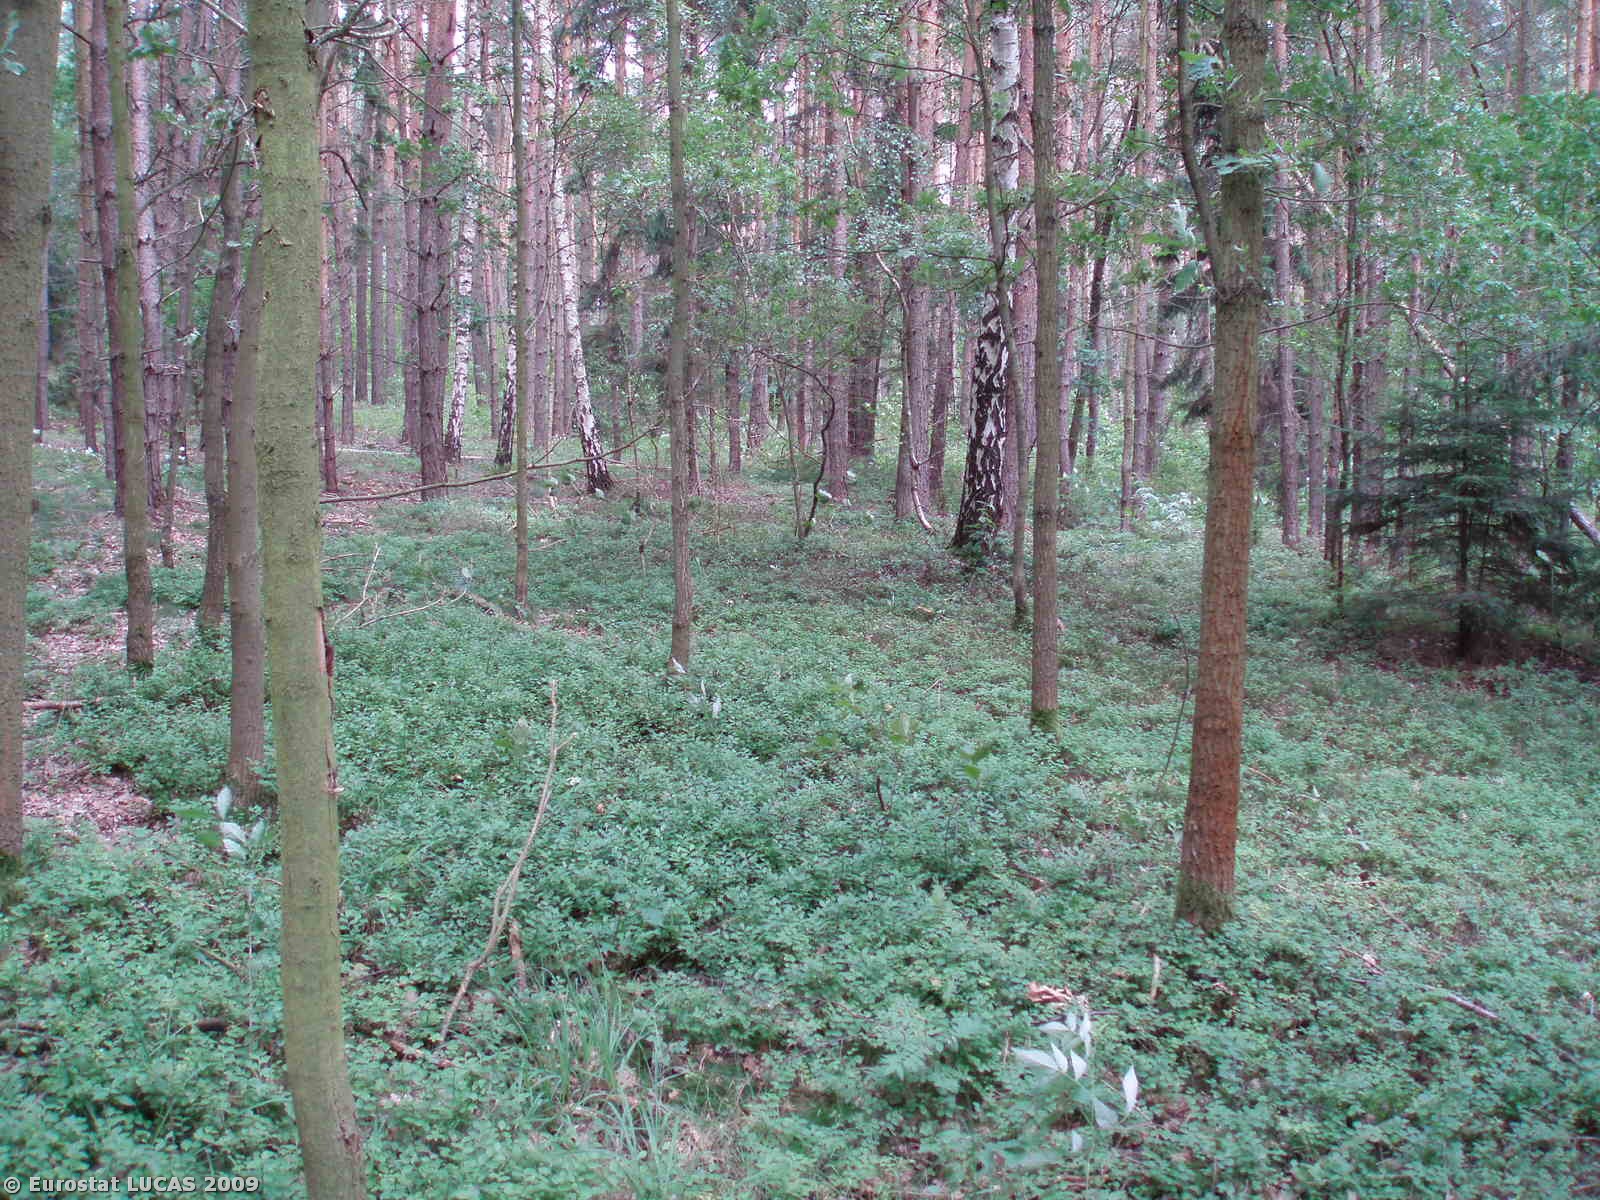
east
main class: Woodland
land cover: Mixed woodland
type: hemiboreal forest and nemoral coniferous forest and mixed broadleaved-coniferous forest
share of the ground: > 75 %
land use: Forestry
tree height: > 5 m
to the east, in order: Mixed woodland; Tracks; Mixed woodland; Coniferous woodland; Fences; Grassland with sparse tree/shrub cover; Fences; Mixed woodland
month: July
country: CZ
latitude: 49.5718
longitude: 12.8898
